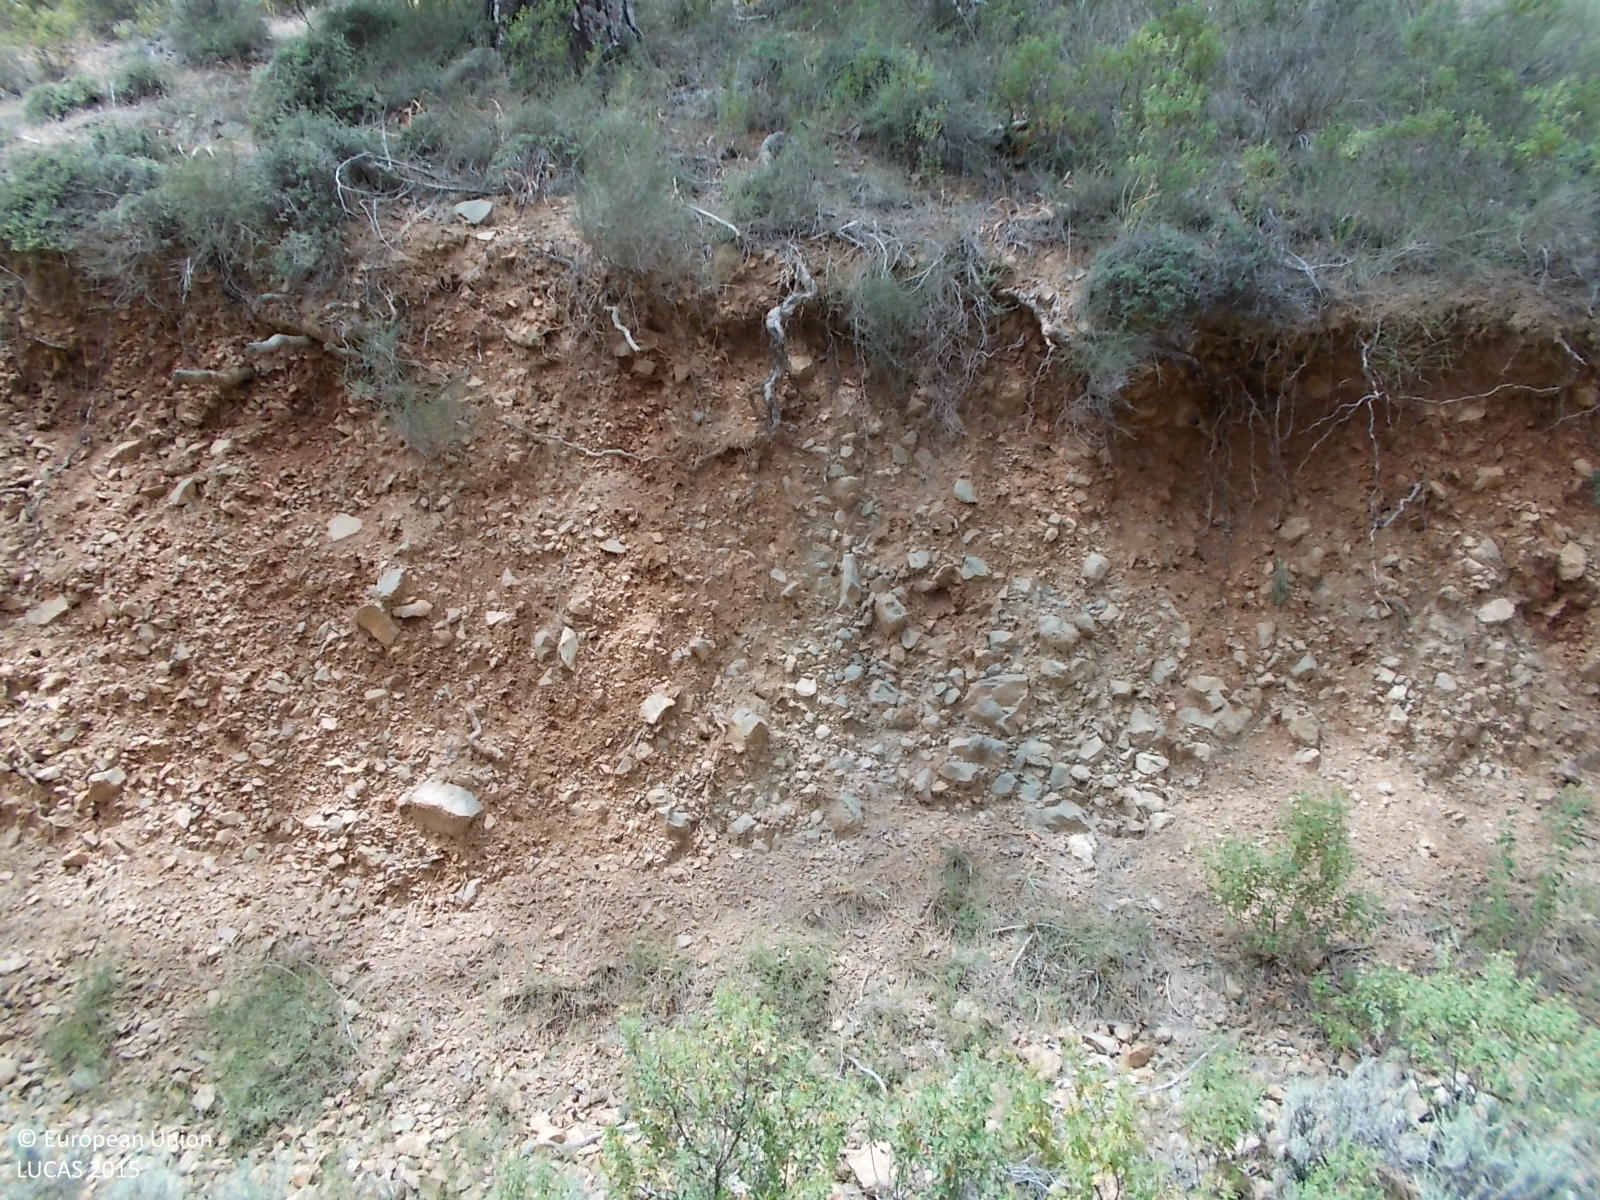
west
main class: Woodland
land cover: Pine dominated coniferous woodland
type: coniferous forest of the mediterranean region
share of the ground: > 75 %
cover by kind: coniferous forest trees 90 %, shrubs 10 %
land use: Semi-natural and natural areas not in use
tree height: > 5 m
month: May
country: CY
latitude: 34.9529
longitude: 32.5944
